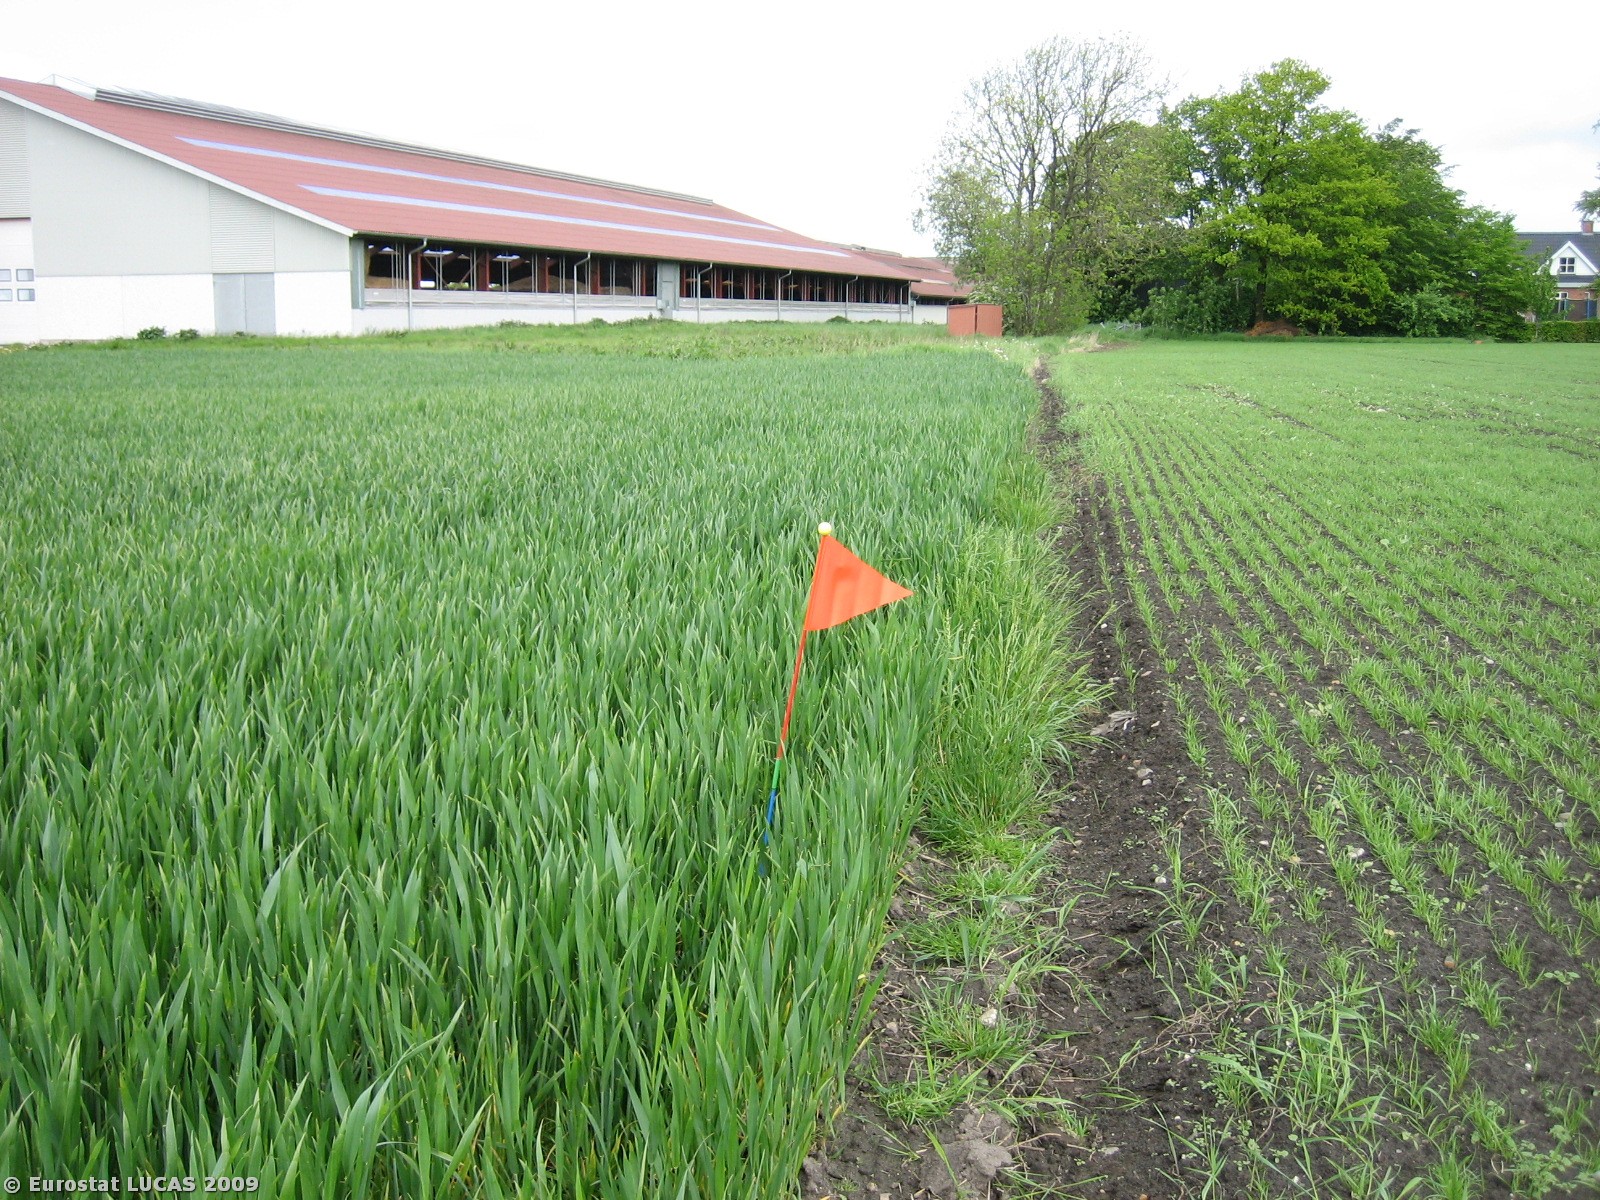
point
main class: Cropland
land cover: Common wheat
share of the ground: > 75 %
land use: Agriculture (excluding fallow land and kitchen gardens)
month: May
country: DK
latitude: 56.1824
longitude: 8.8253
